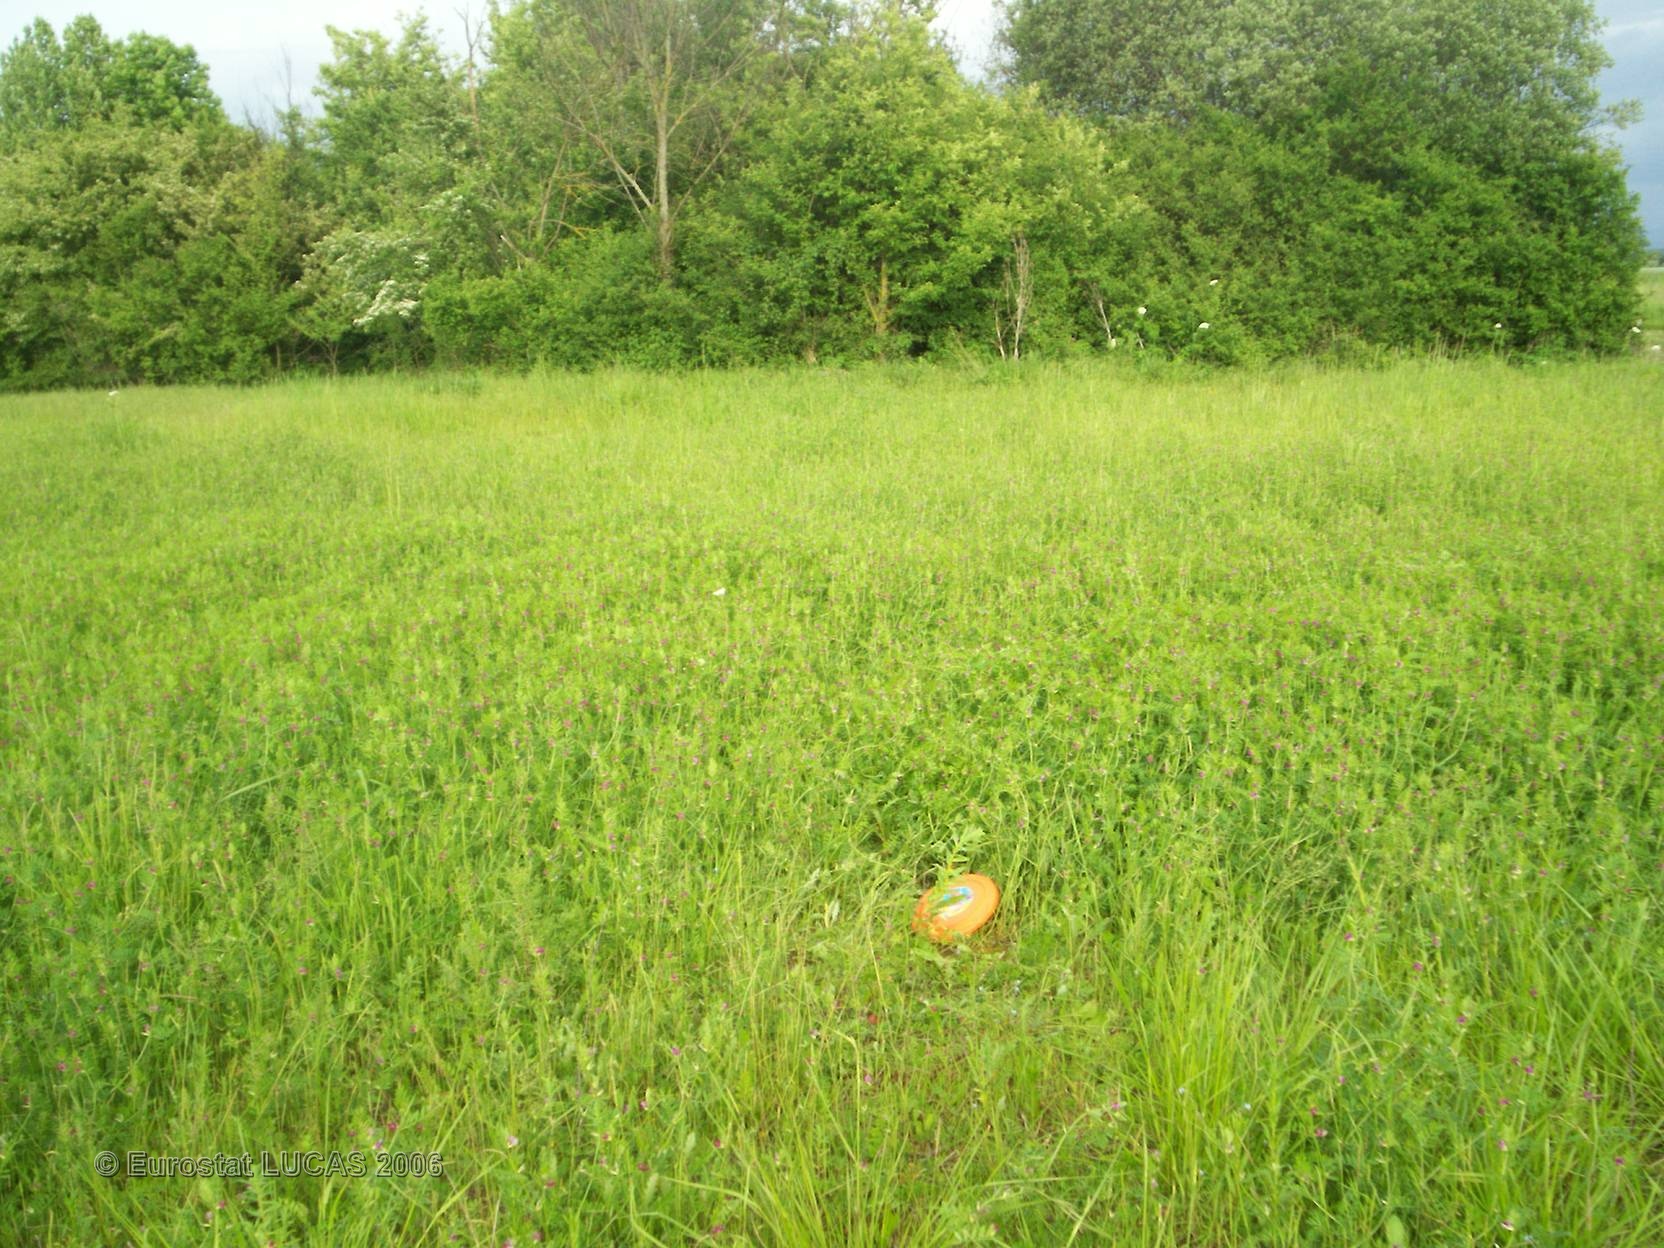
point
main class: Grassland
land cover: Grassland without tree/shrub cover
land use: Agriculture (excluding fallow land and kitchen gardens)
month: May
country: FR
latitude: 46.1545
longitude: 3.2269
